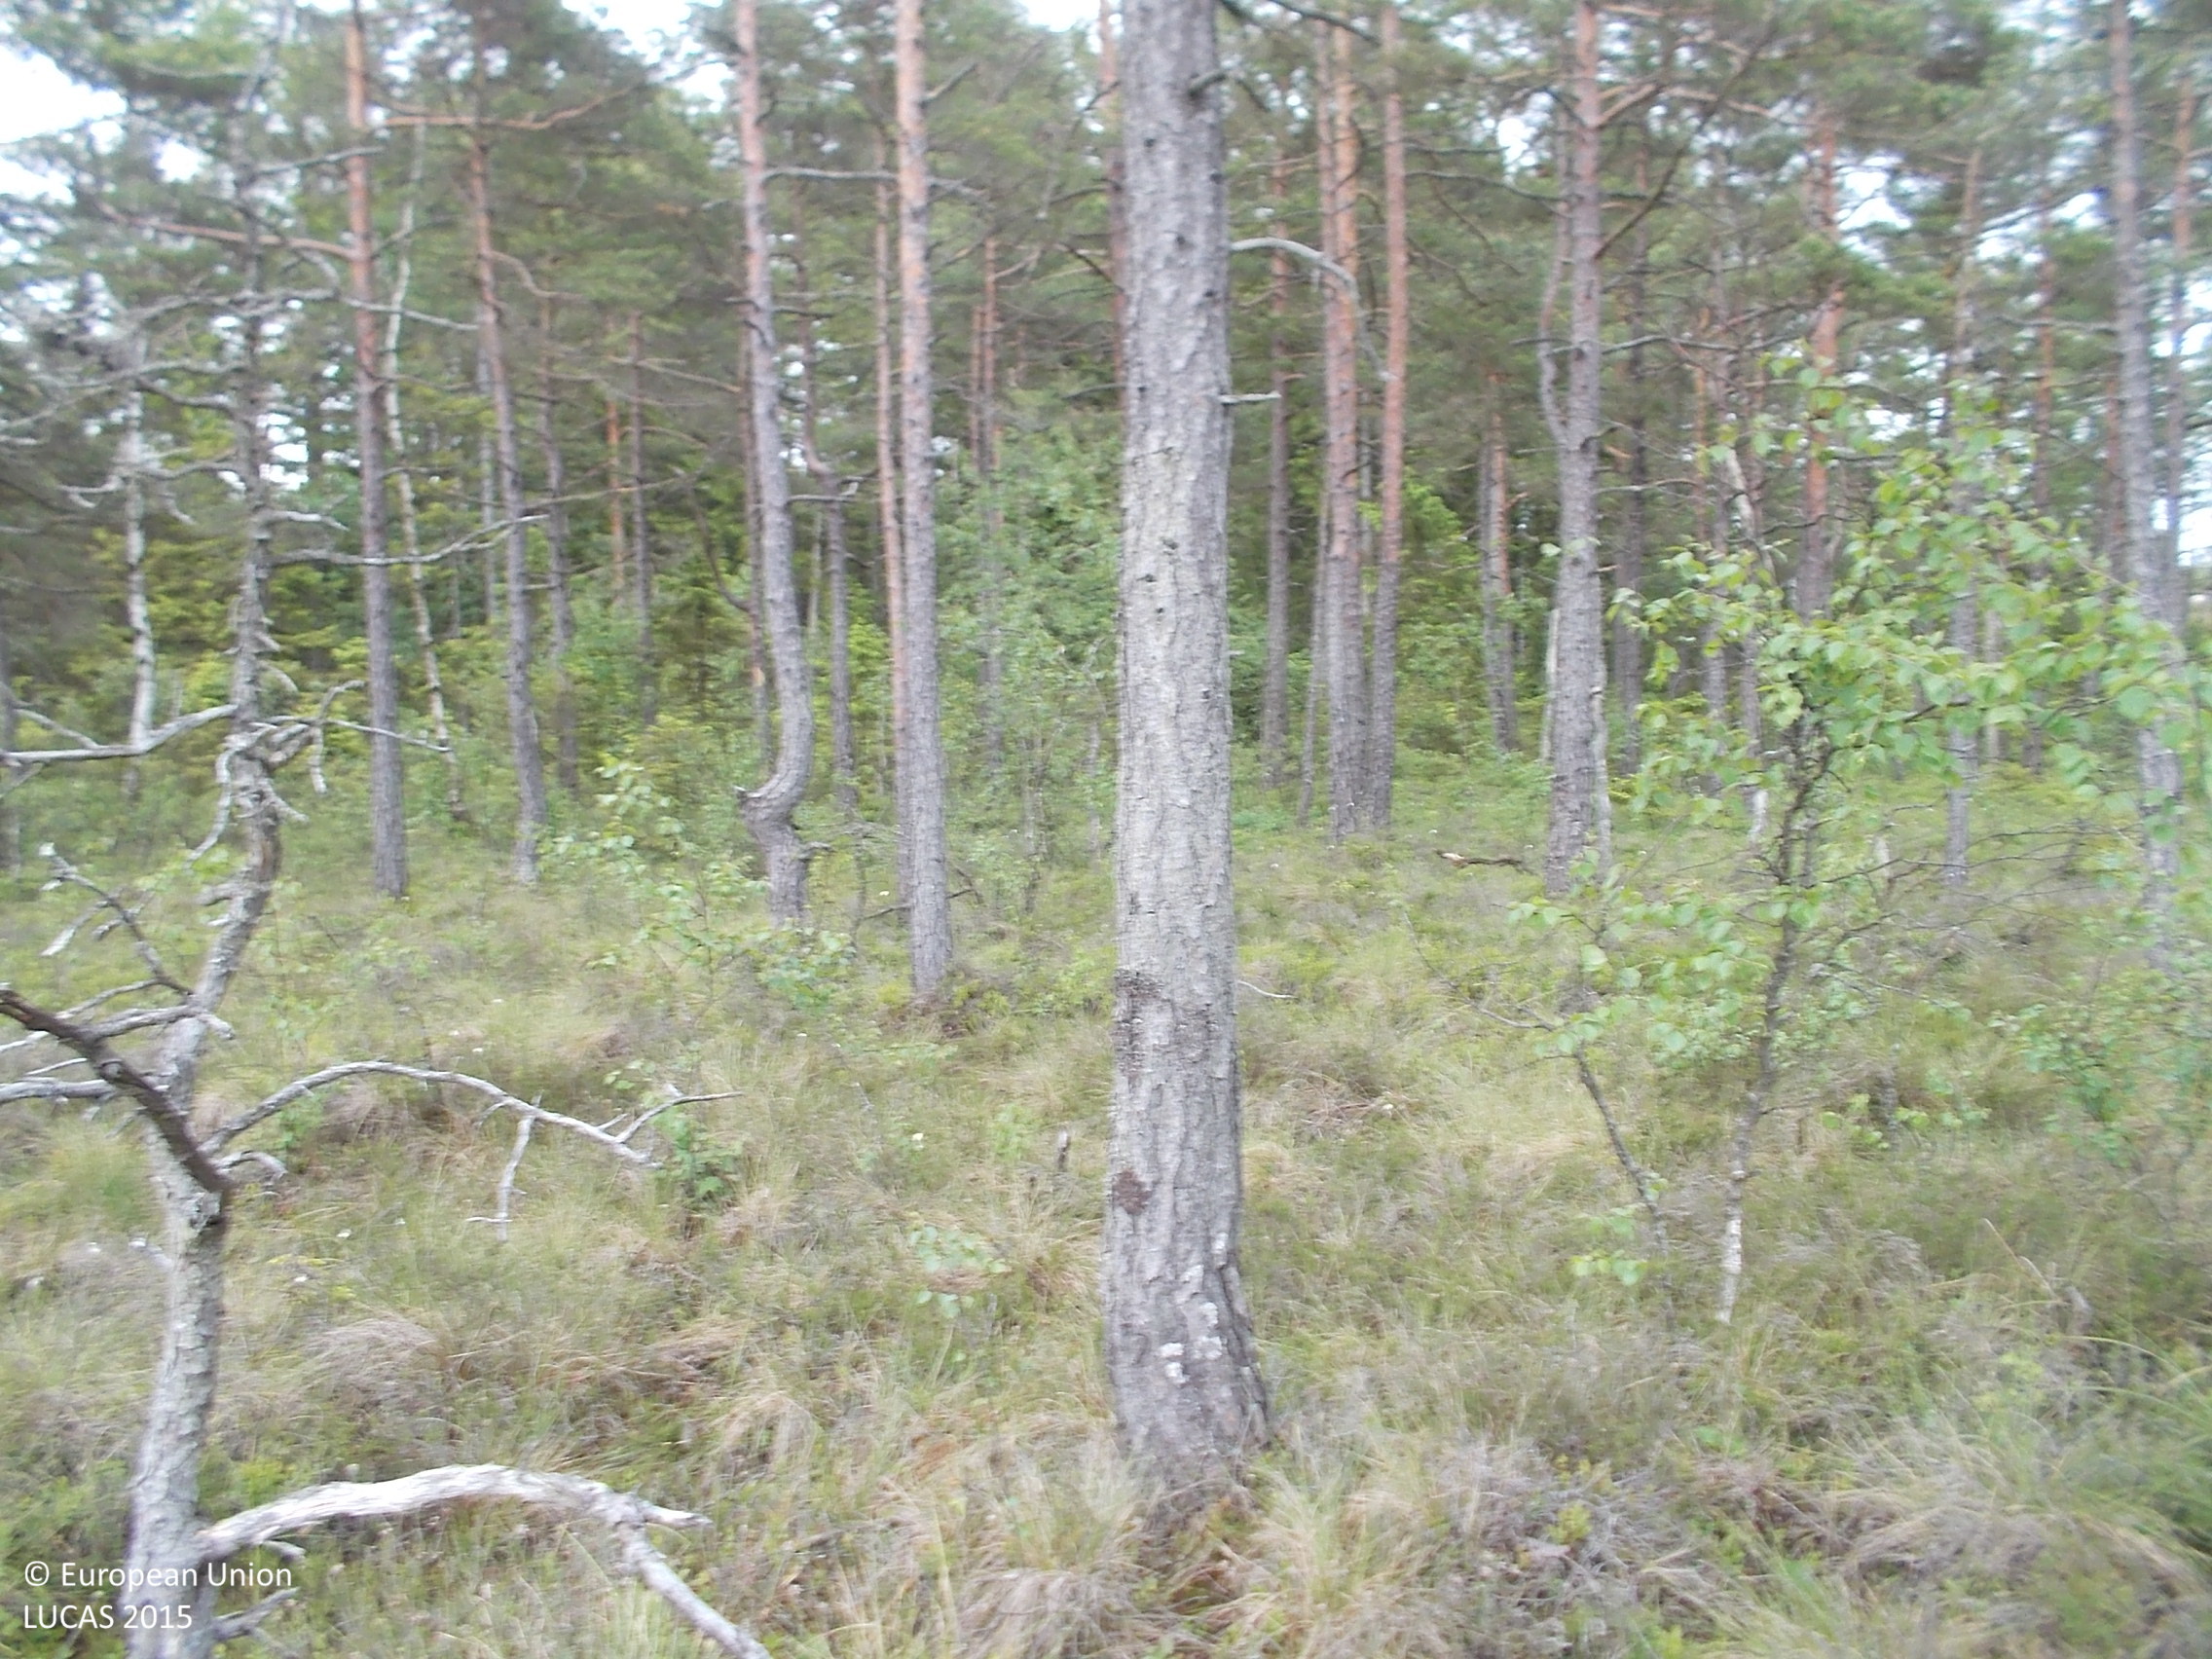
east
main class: Woodland
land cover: Pine dominated coniferous woodland
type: mire and swamp forests
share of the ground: 10 - 25 %
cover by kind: lichens and mosses 55 %, coniferous forest trees 25 %, consolidated bare surface 20 %
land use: Semi-natural and natural areas not in use
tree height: < 5 m
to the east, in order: Pine dominated coniferous woodland; Ditches and canals; Spruce dominated mixed woodland; Pine dominated coniferous woodland; Spruce dominated coniferous woodland; Spruce dominated mixed woodland; Groves; Paved roads, cycling and walking lanes; Groves; Ditches and canals; Pine dominated mixed woodland; Spruce dominated coniferous woodland
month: June
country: SE
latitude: 57.3768
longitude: 12.9730
